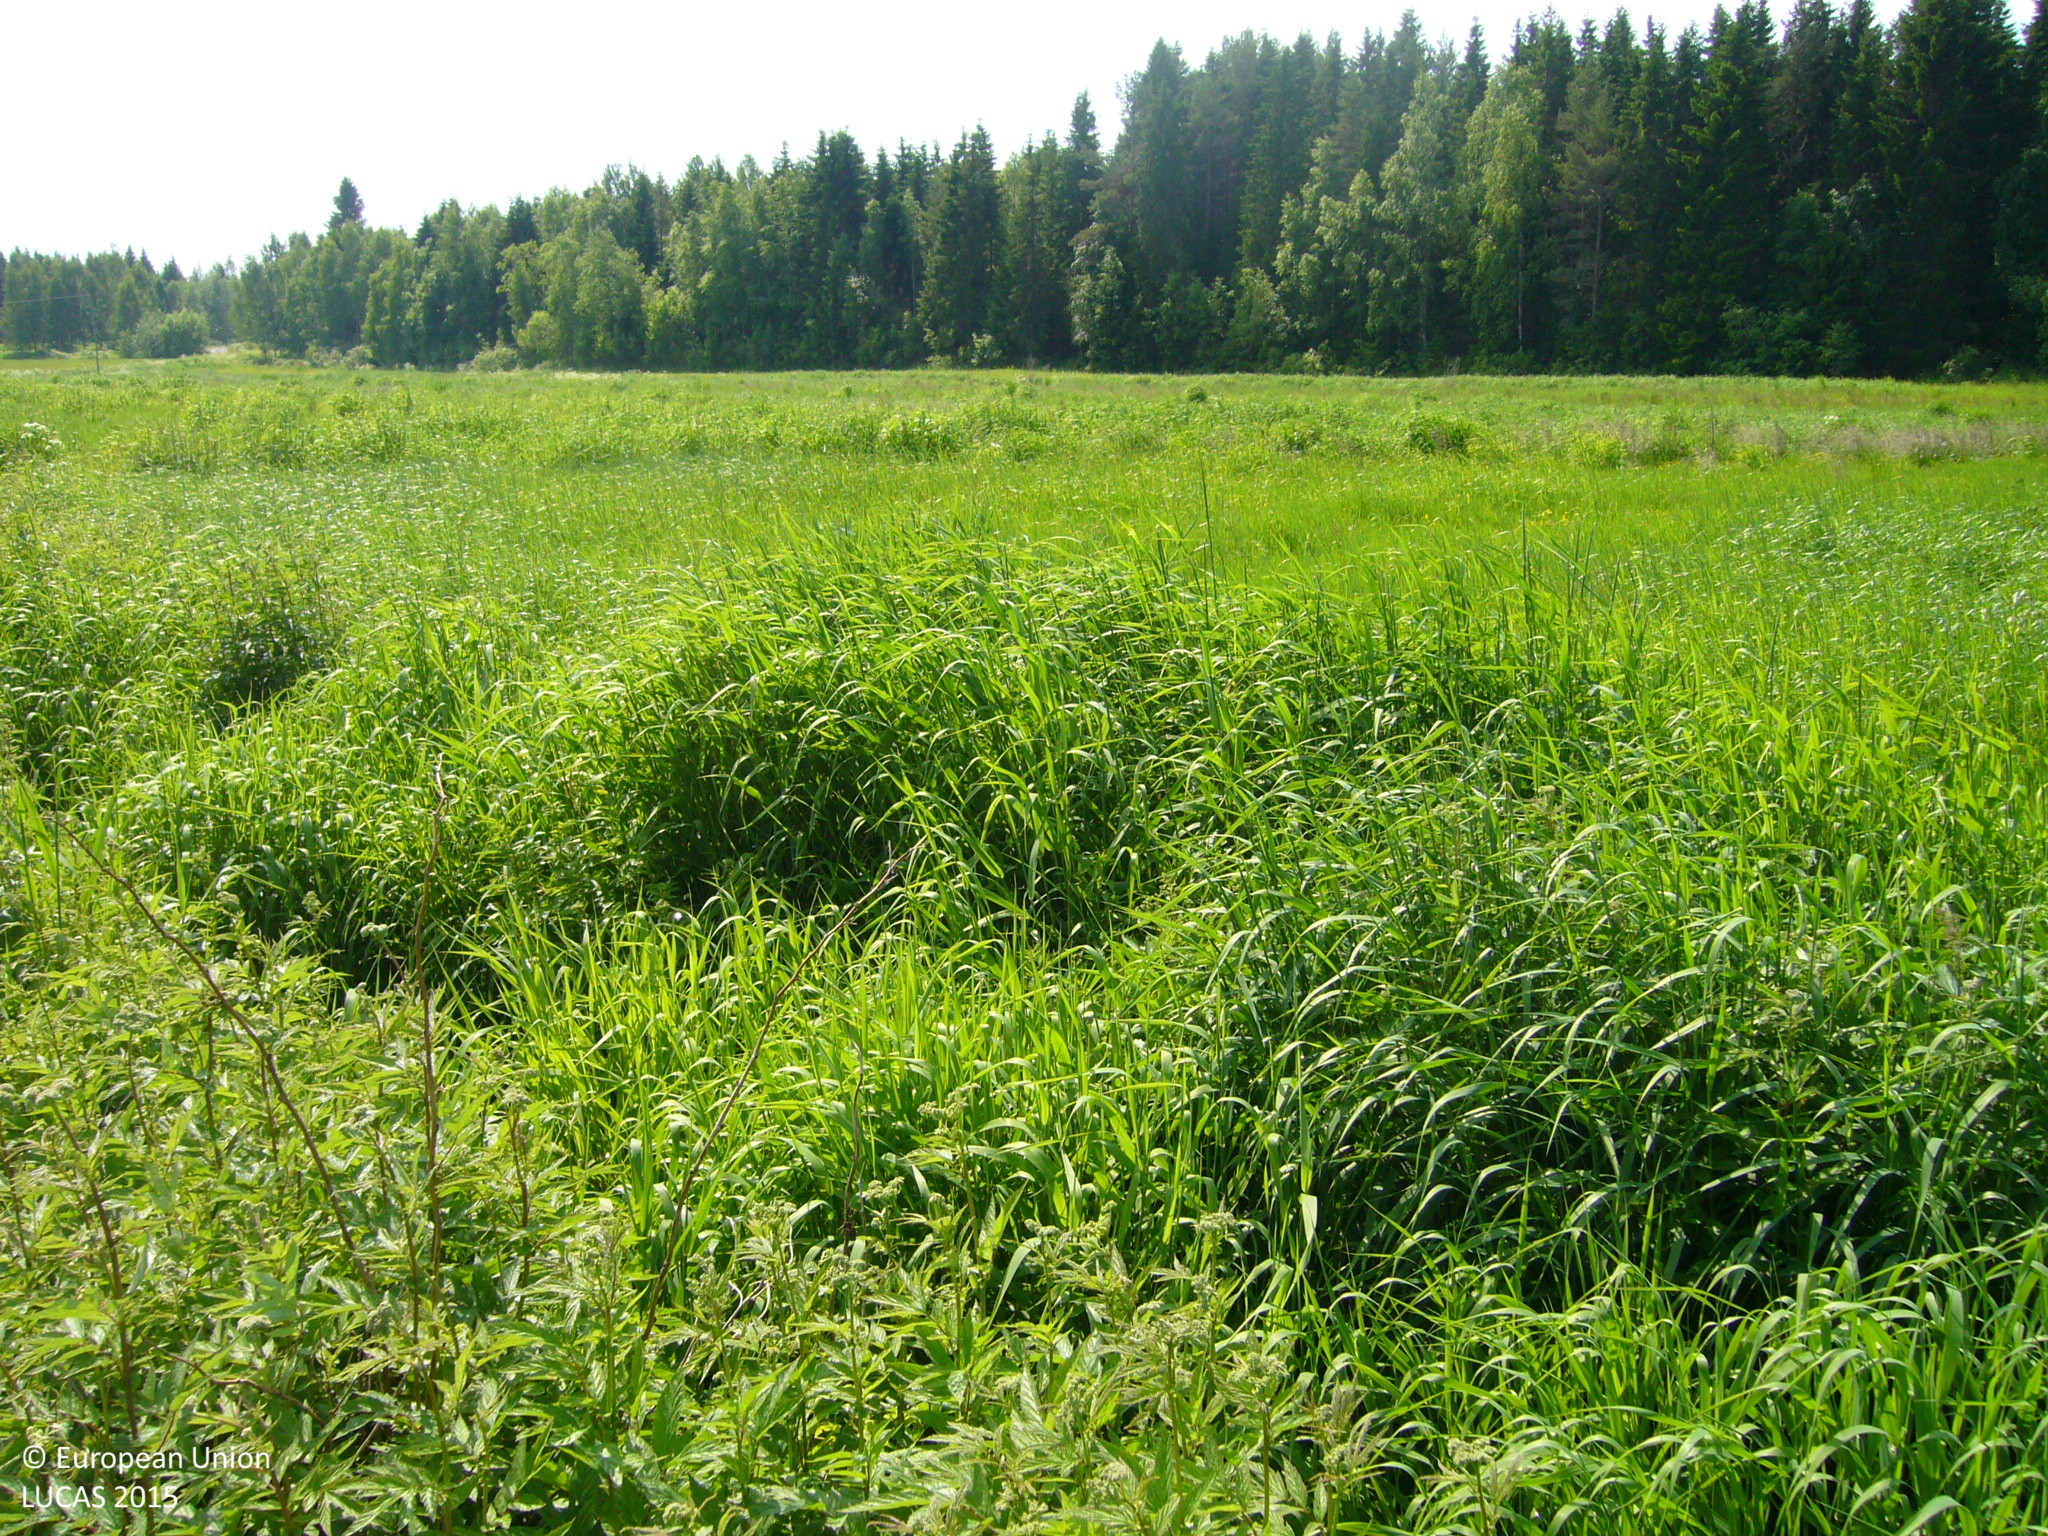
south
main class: Cropland
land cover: Temporary grasslands
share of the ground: > 75 %
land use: Agriculture (excluding fallow land and kitchen gardens)
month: July
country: FI
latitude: 63.6330
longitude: 25.8294
